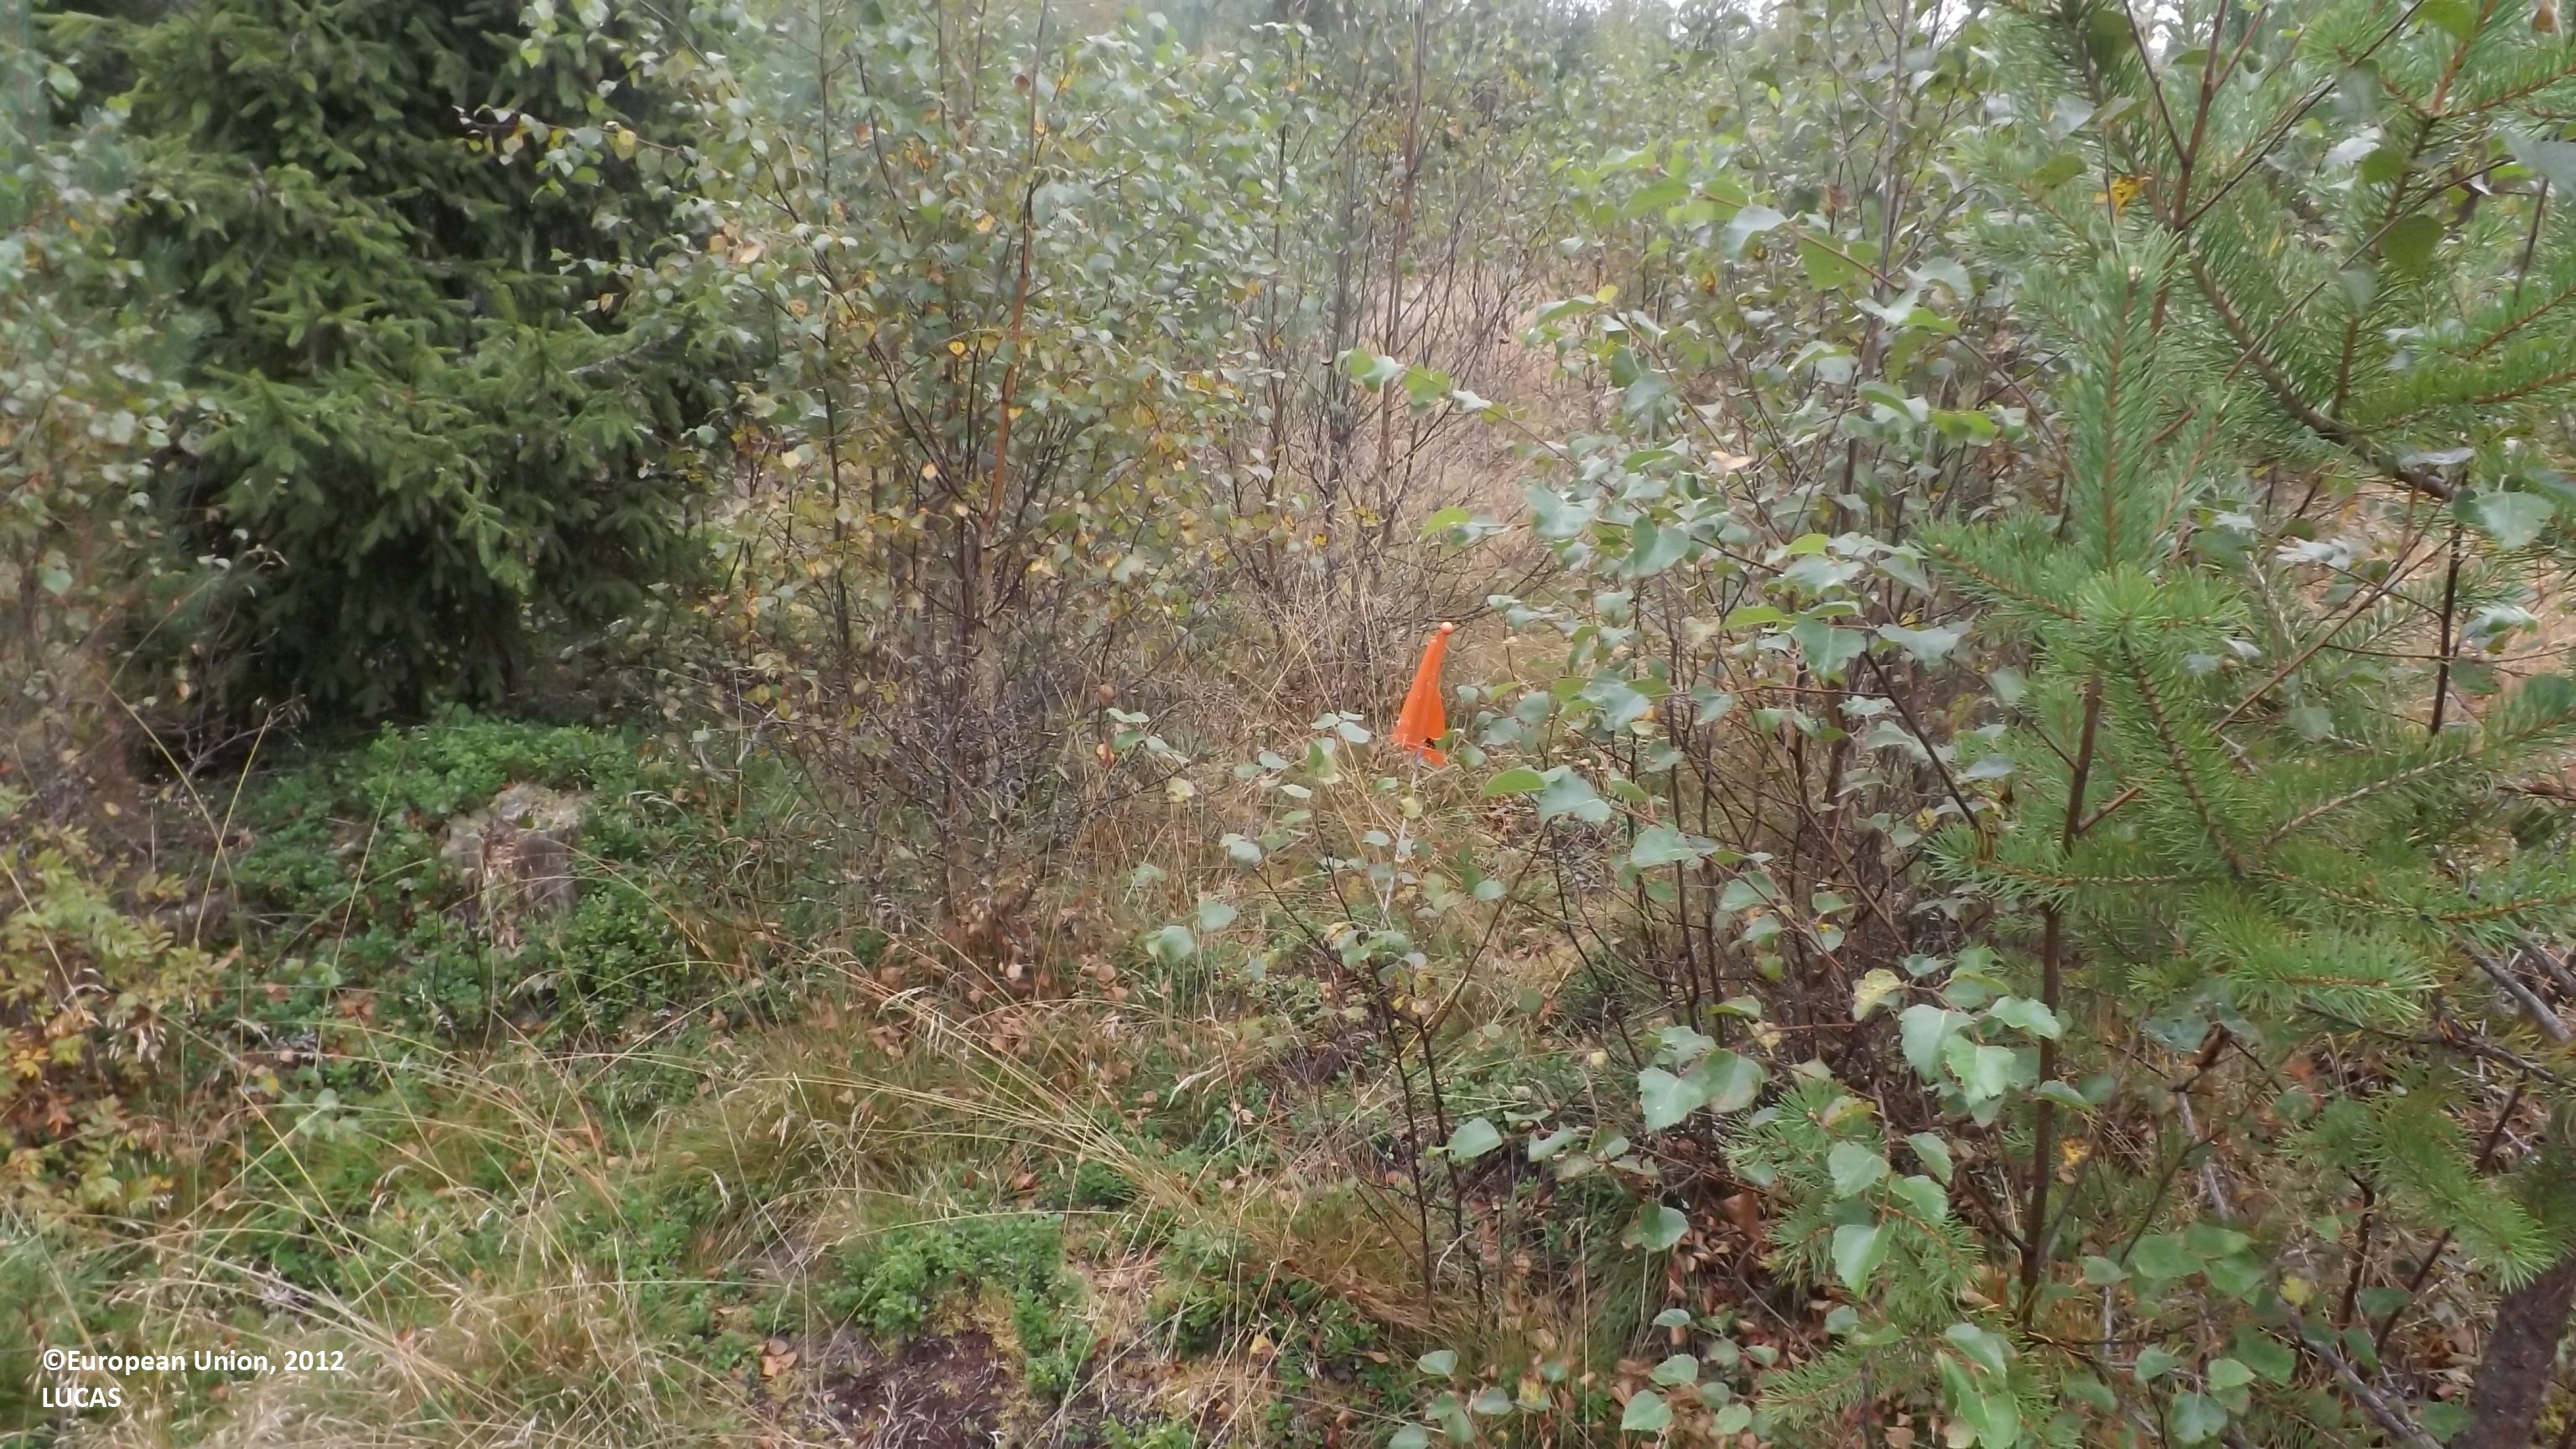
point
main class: Woodland
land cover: Pine dominated mixed woodland
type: boreal forest
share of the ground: 25 - 50 %
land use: Forestry
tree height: < 5 m
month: August
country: FI
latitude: 63.9499
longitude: 23.8809
